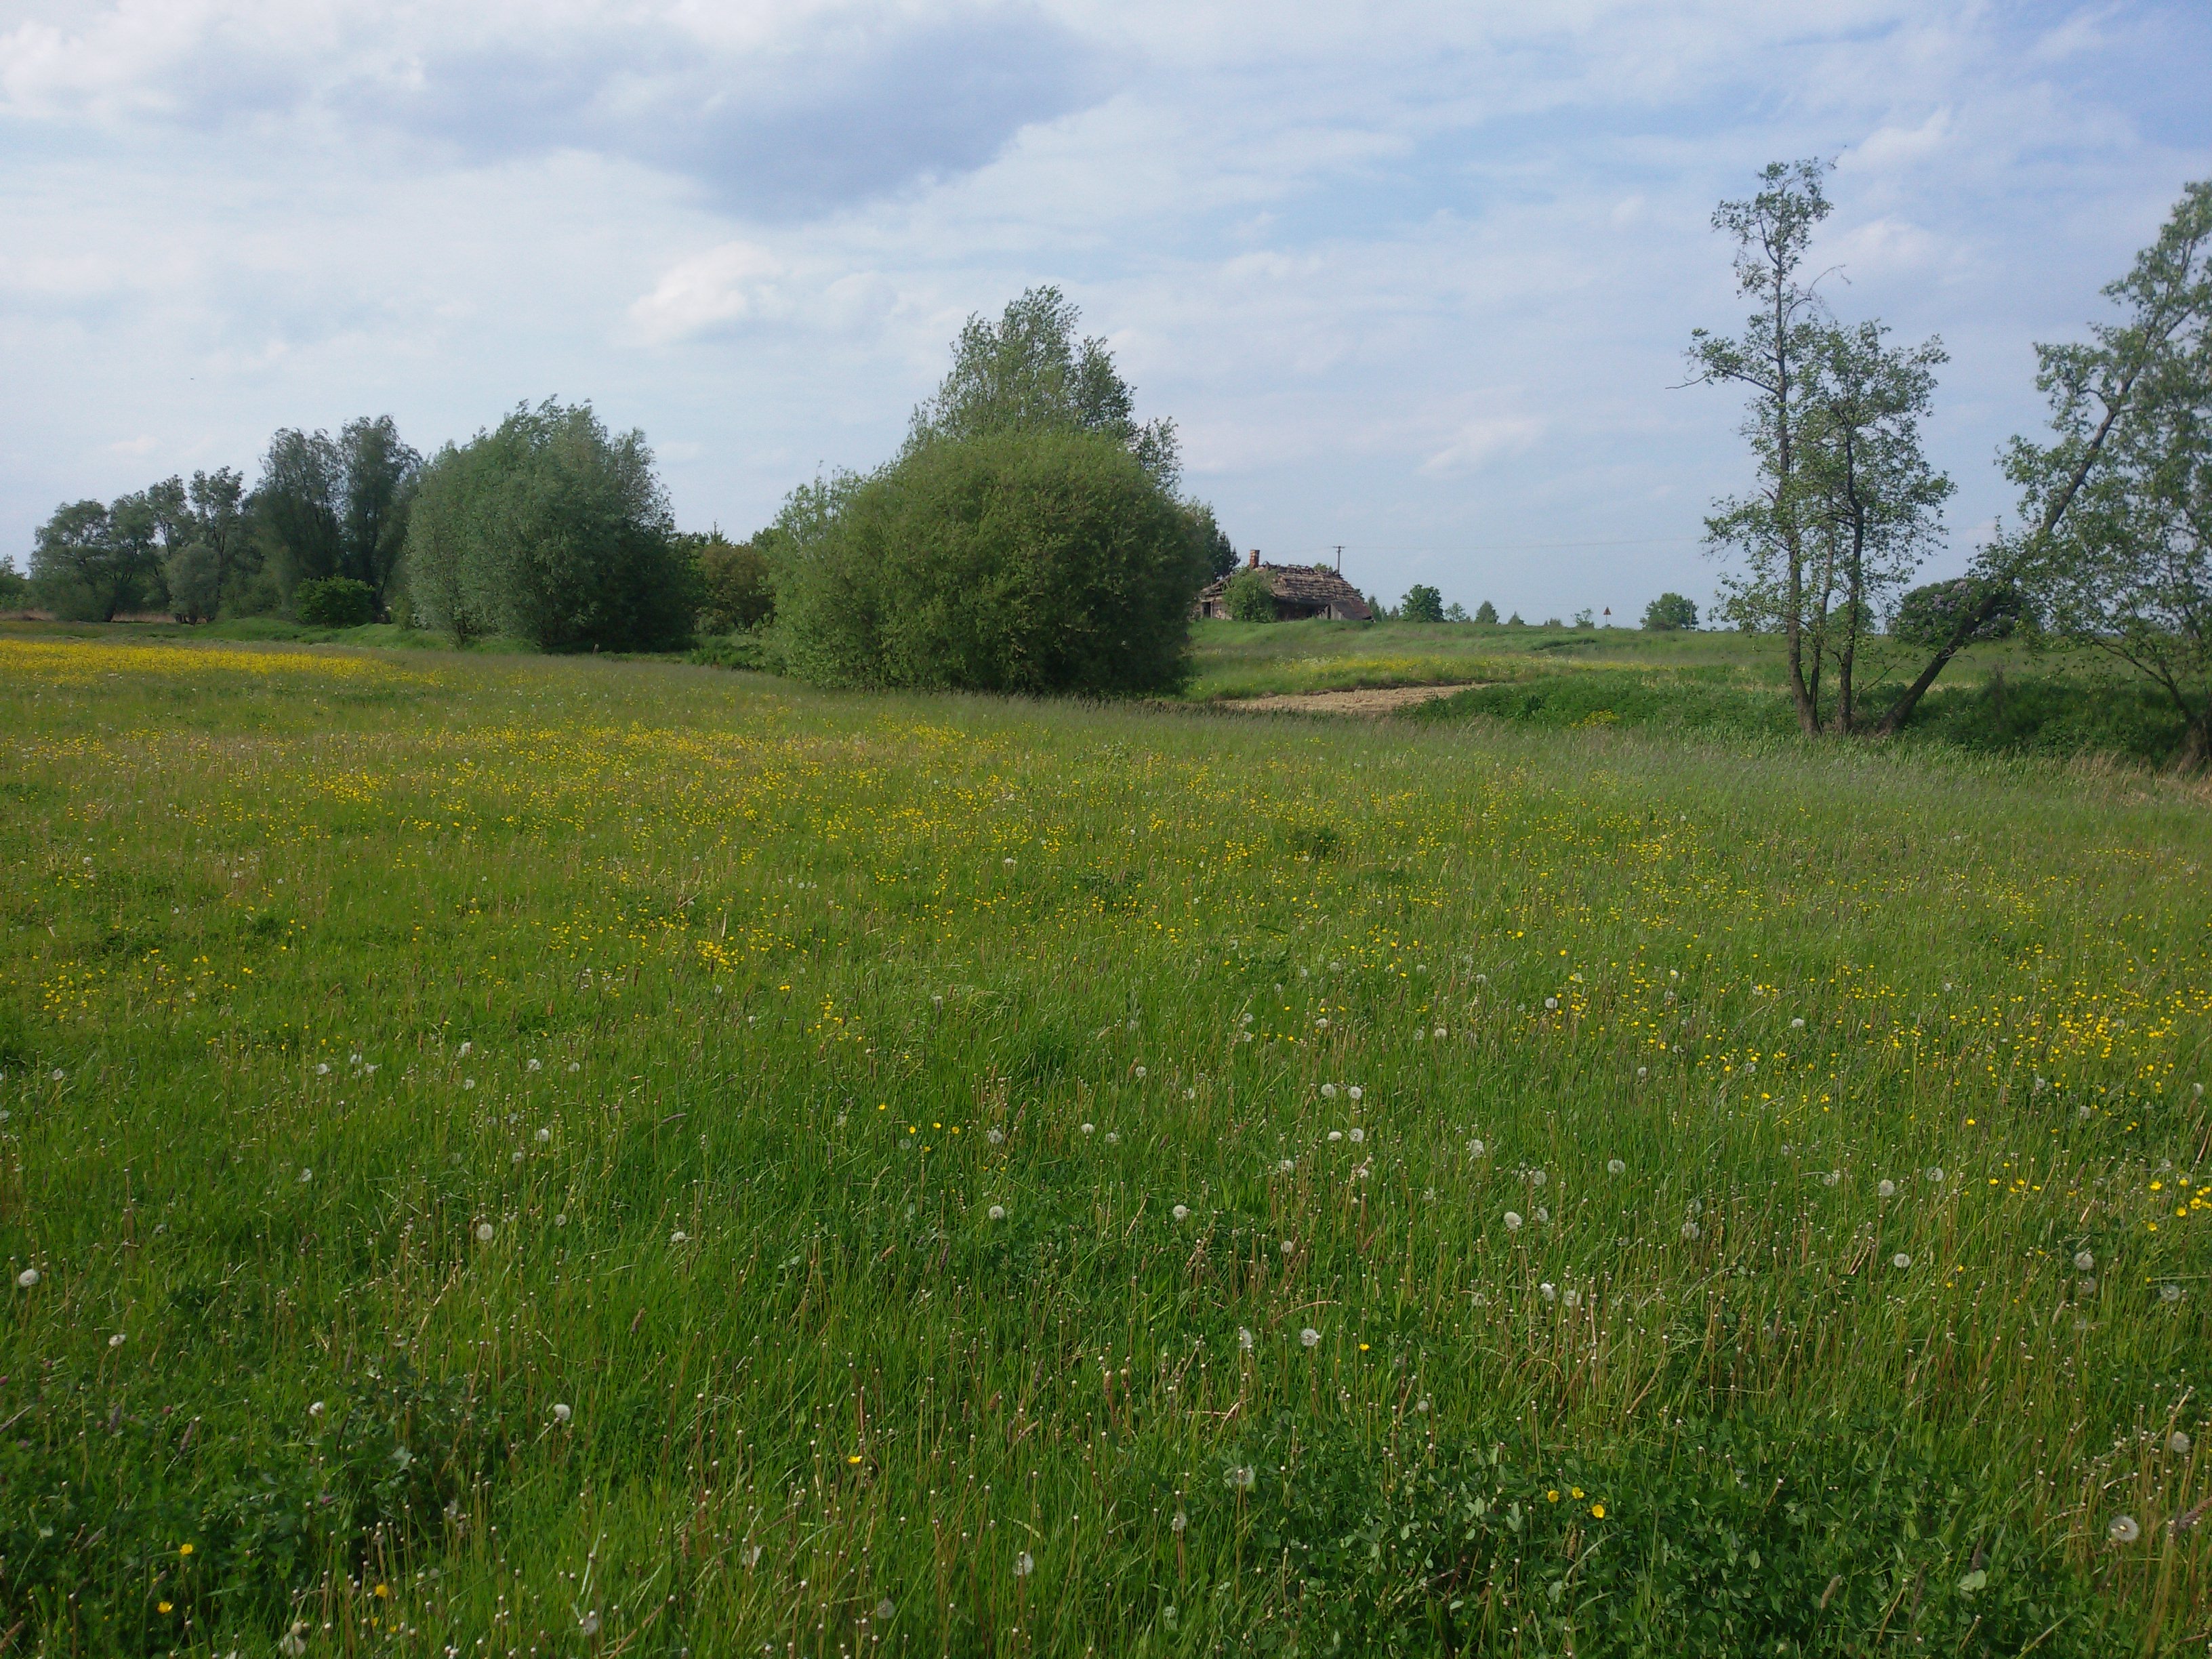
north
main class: Grassland
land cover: Grassland without tree/shrub cover
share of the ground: > 75 %
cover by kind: herbaceous plants 100 %
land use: Agriculture (excluding fallow land and kitchen gardens)
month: May
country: PL
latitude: 51.6197
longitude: 21.6514
